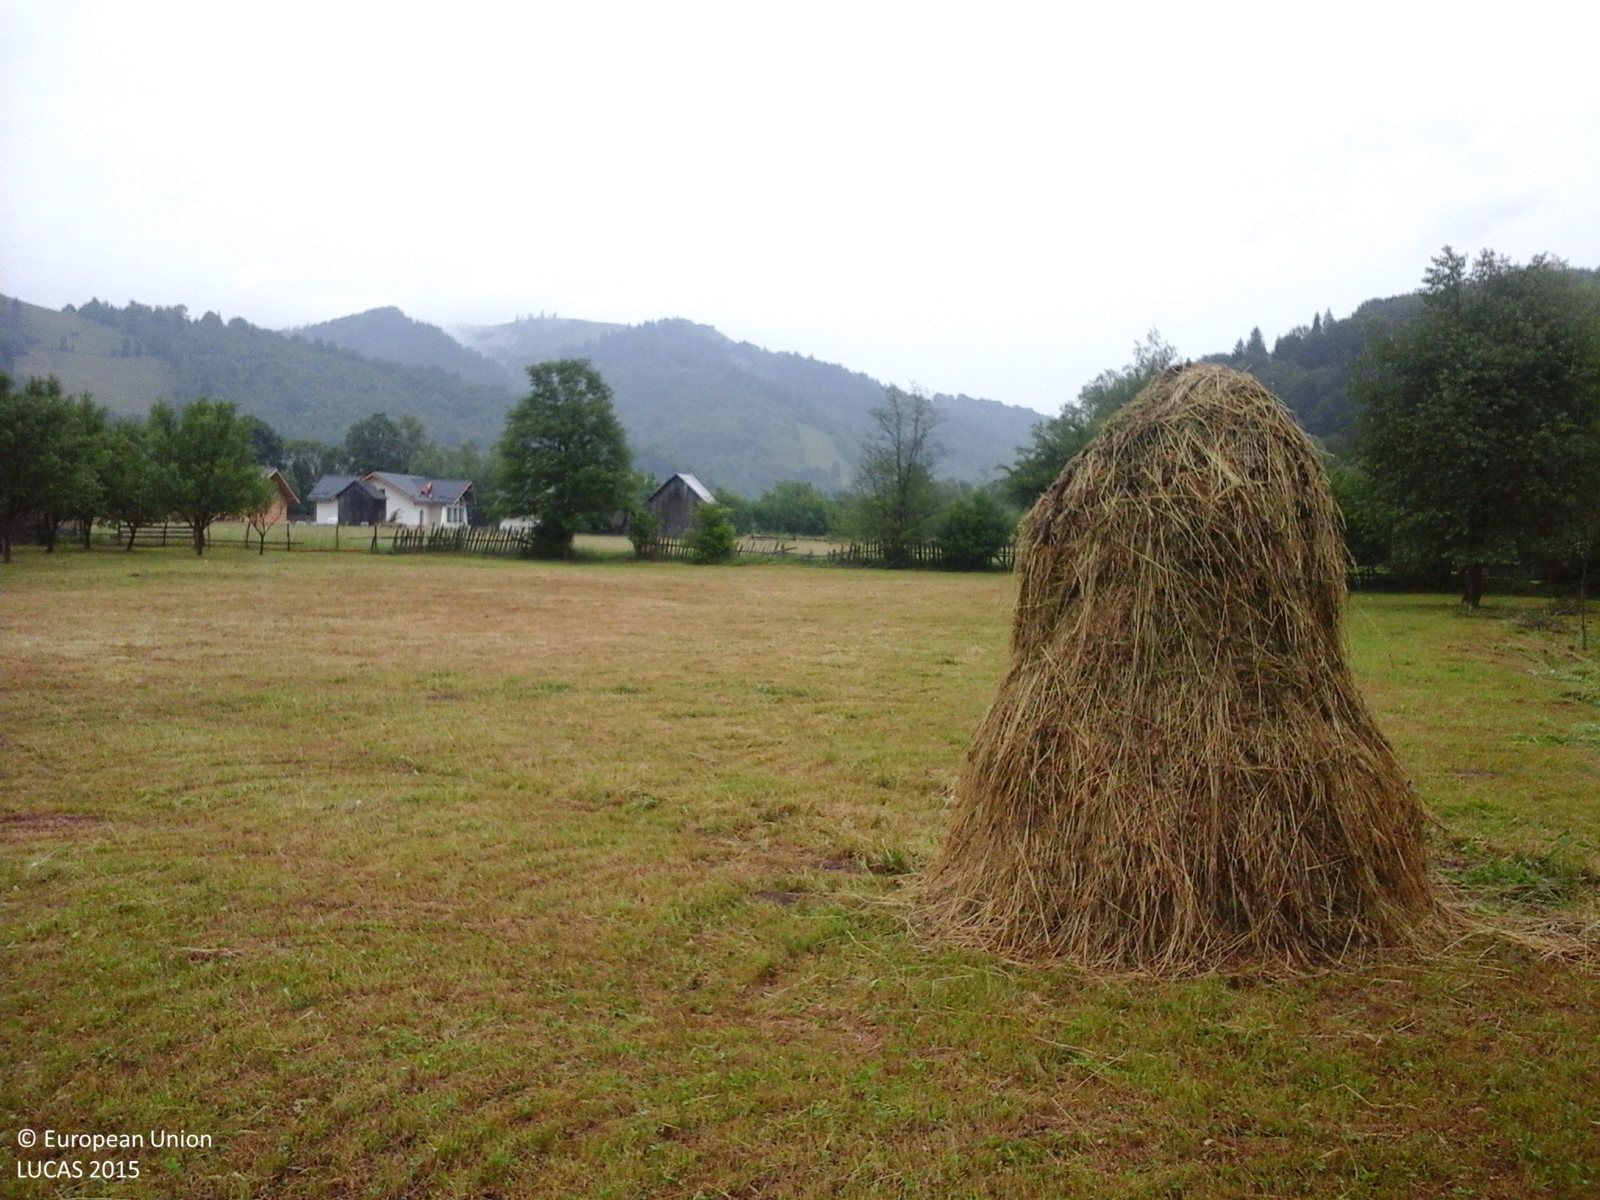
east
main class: Cropland
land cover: Other leguminous and mixtures for fodder
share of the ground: > 75 %
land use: Agriculture (excluding fallow land and kitchen gardens)
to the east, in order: Other leguminous and mixtures for fodder; Fences; Lines of trees; Grassland without tree/shrub cover; Artificial constructions in urban areas; Grassland without tree/shrub cover; Fences; Rivers and streams; Lines of trees; Fences; Grassland without tree/shrub cover
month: June
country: RO
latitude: 47.5603
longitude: 25.7386
